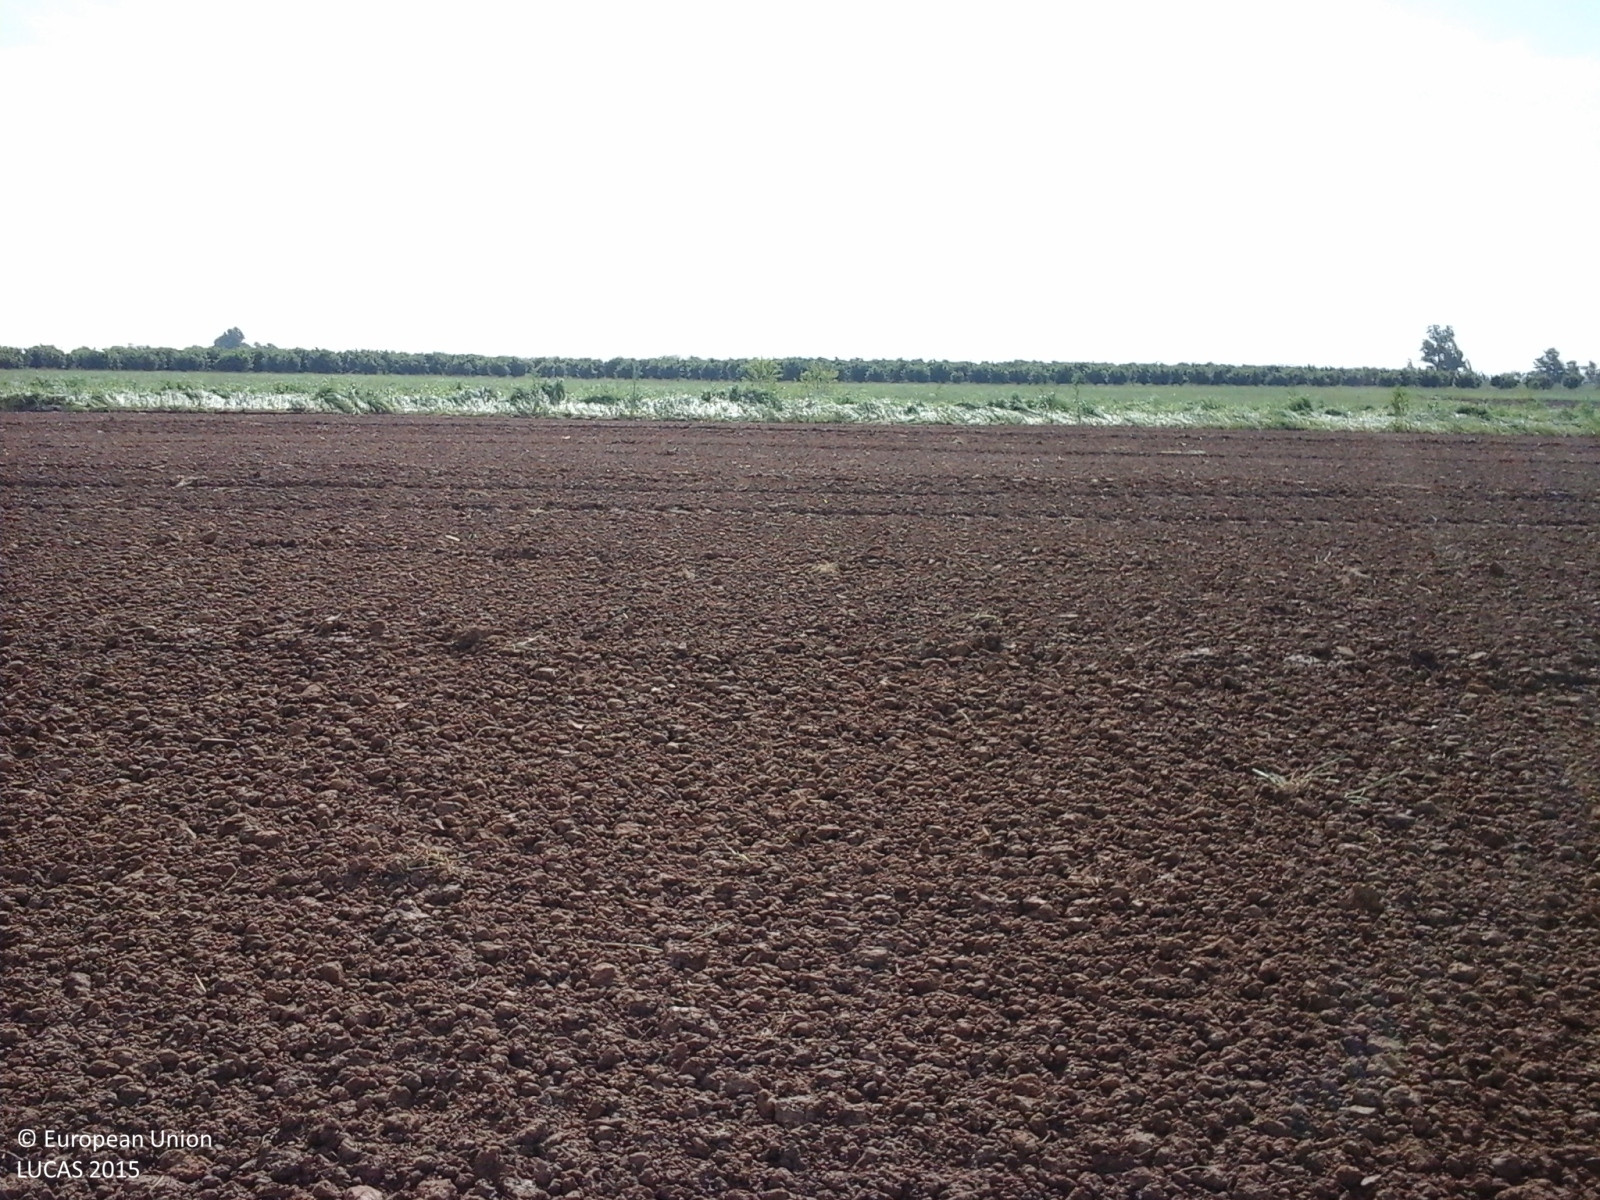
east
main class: Cropland
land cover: Maize
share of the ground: < 10 %
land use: Agriculture (excluding fallow land and kitchen gardens)
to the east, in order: Maize; Temporary grasslands; Maize; Ditches and canals; Maize; Temporary grasslands; Nuts trees; Common wheat
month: May
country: IT
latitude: 44.5438
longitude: 7.8019
